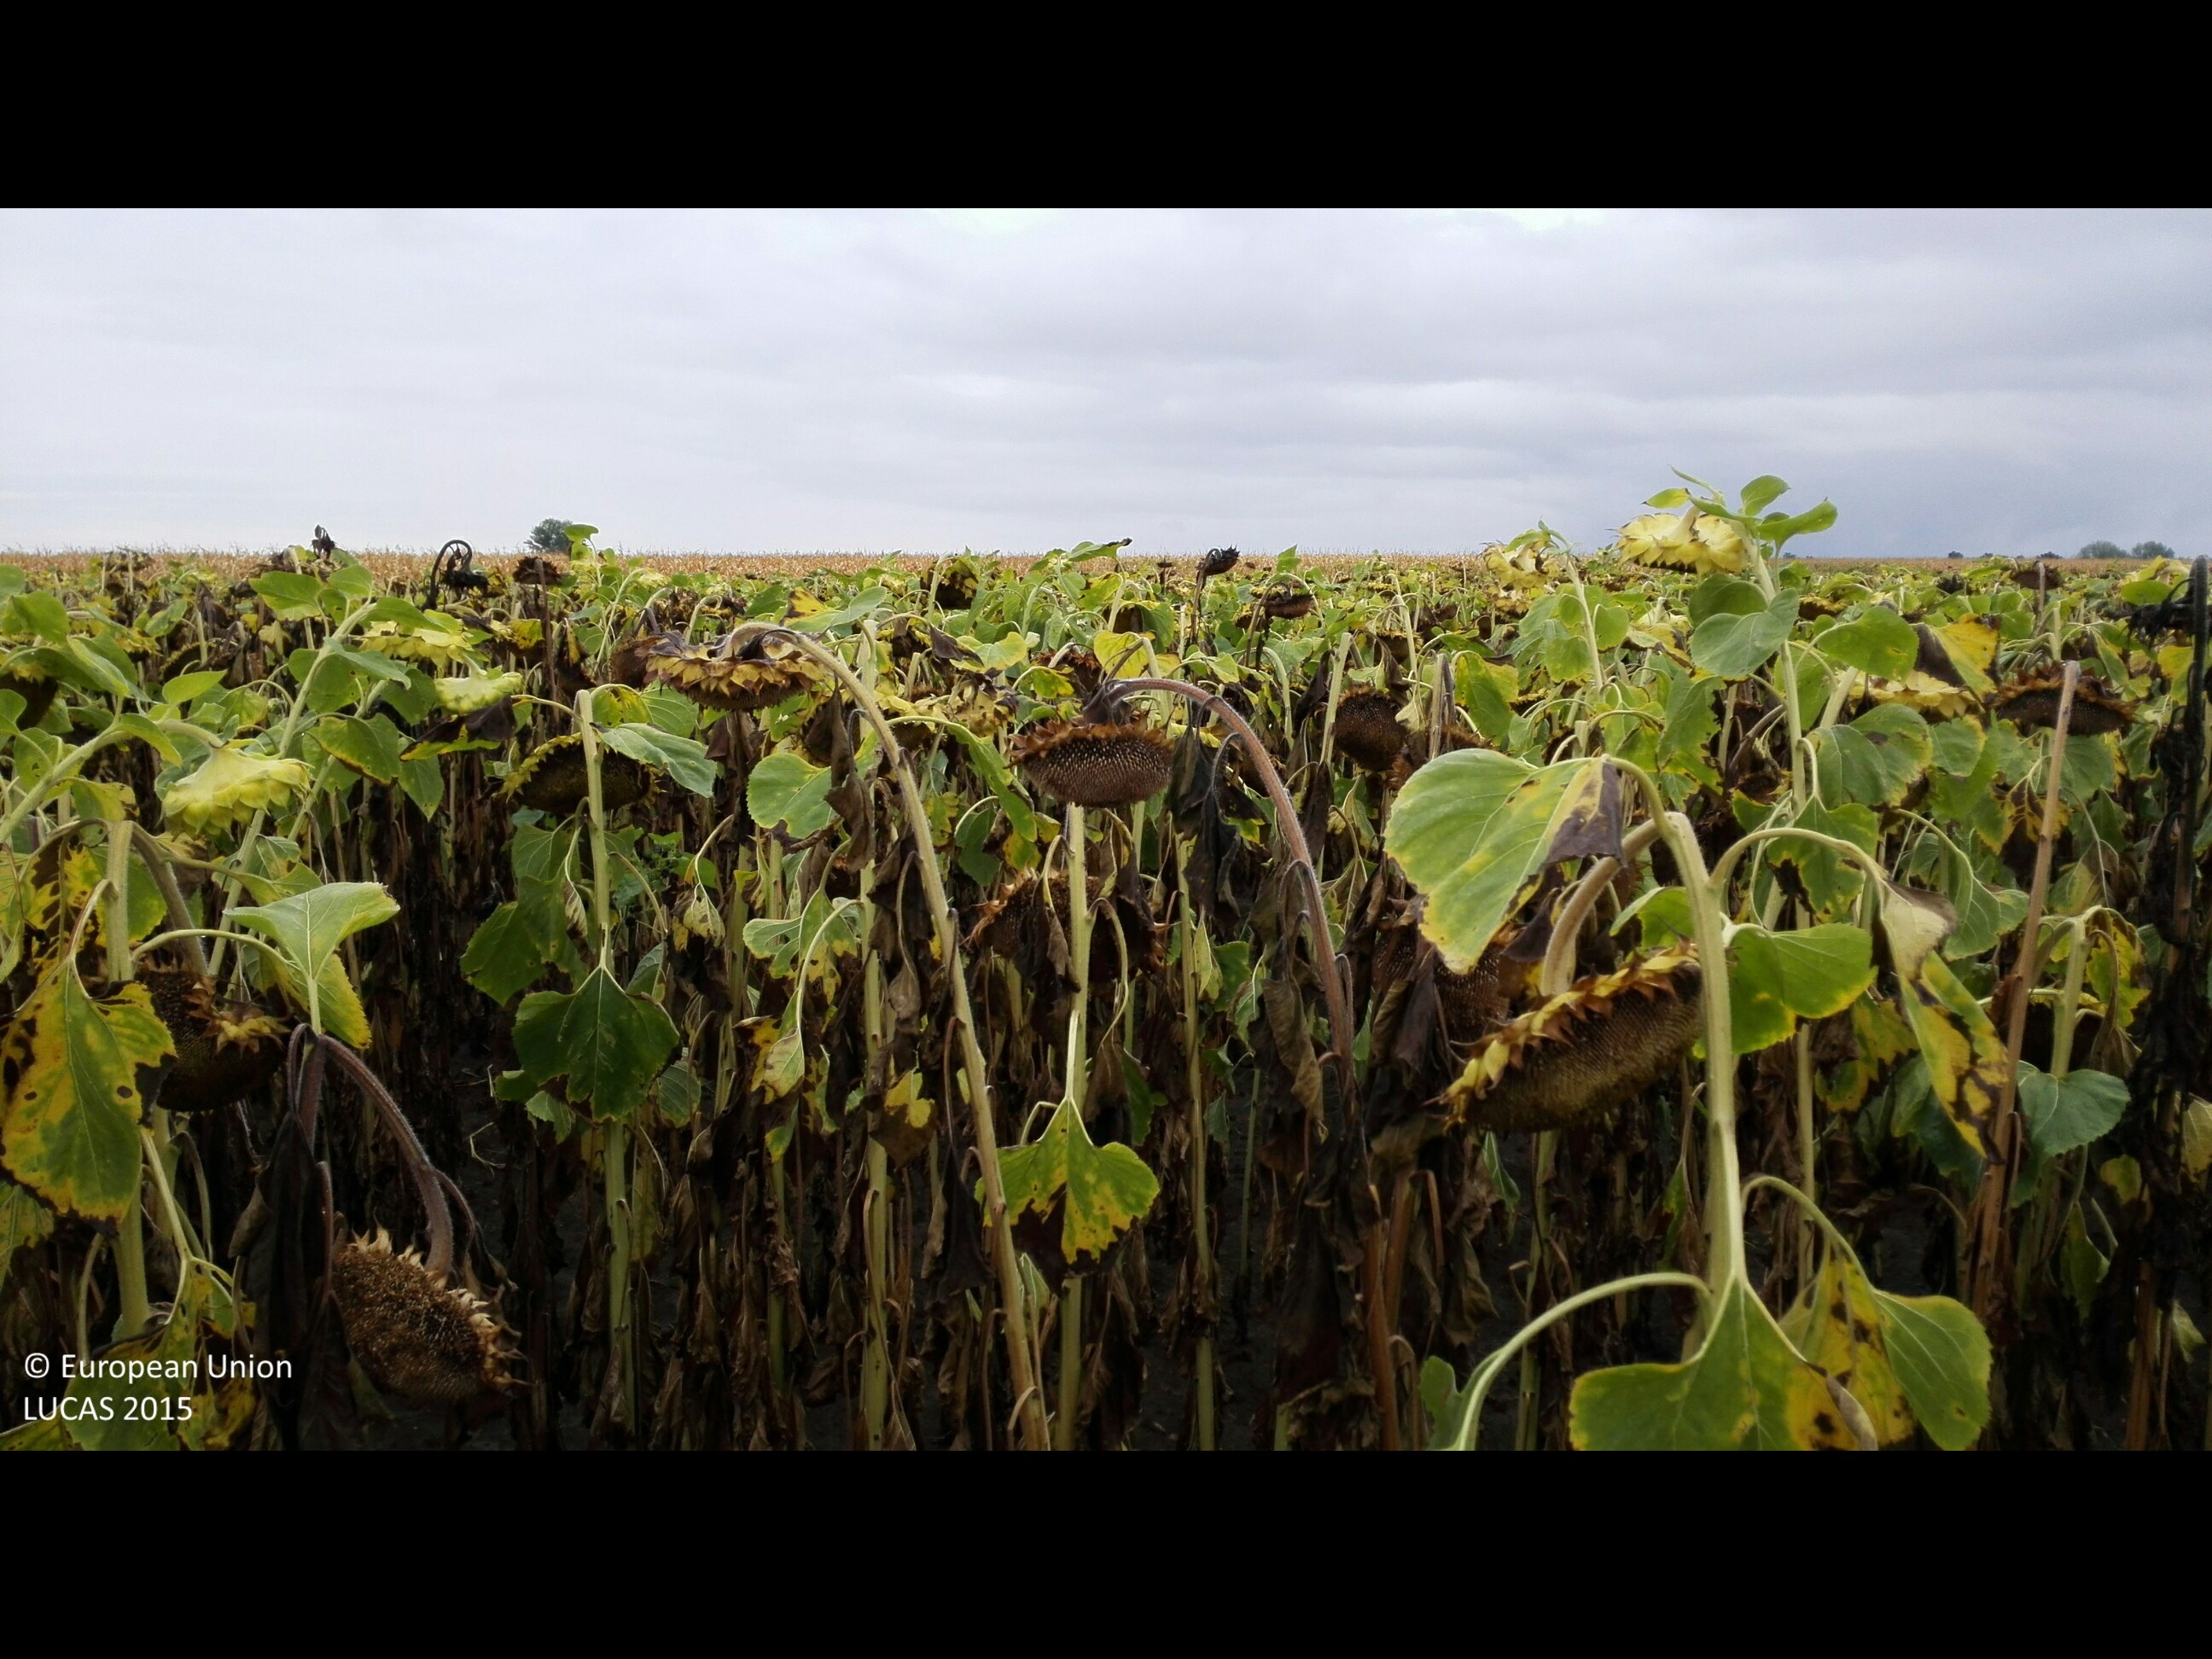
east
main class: Cropland
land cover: Sunflower
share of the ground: > 75 %
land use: Agriculture (excluding fallow land and kitchen gardens)
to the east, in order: Sunflower; Grass margins; Tracks; Grass margins; Maize; Grass margins; Tracks; Grass margins; Maize
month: August
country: HU
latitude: 47.3110
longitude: 21.8324
